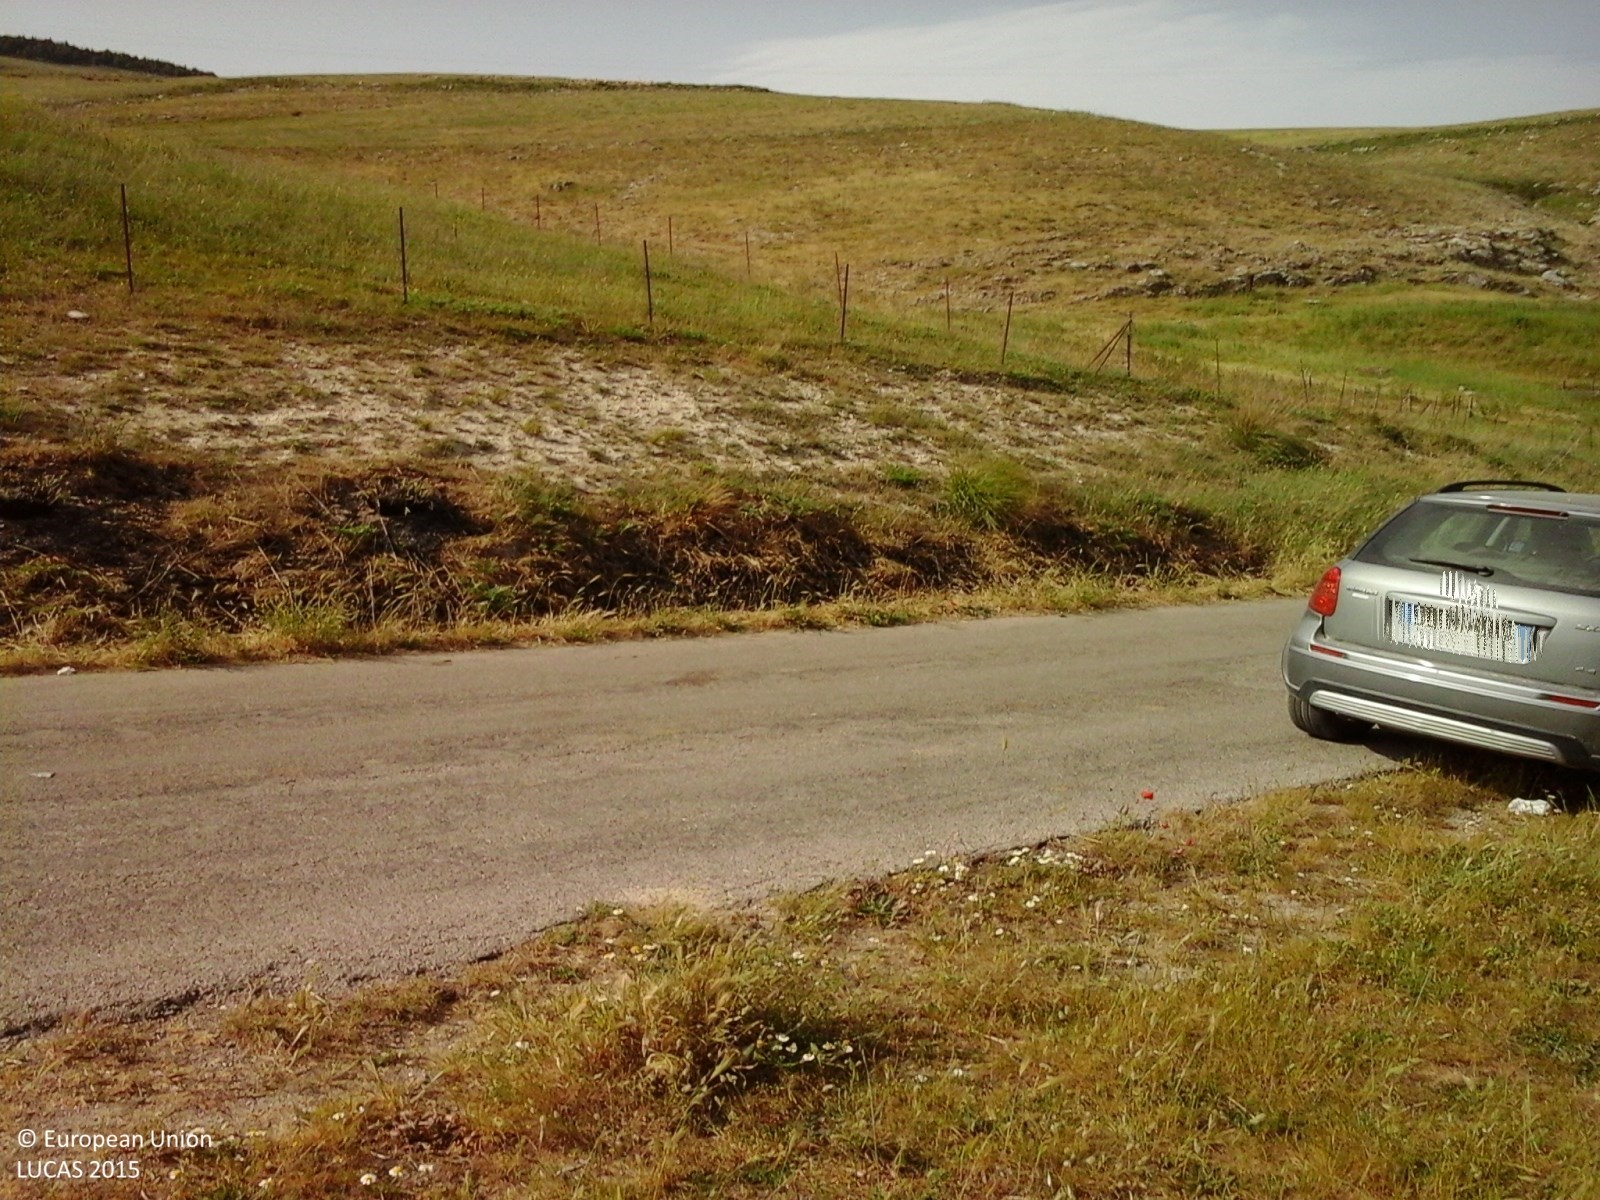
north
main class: Shrubland
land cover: Shrubland with sparse tree cover
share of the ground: > 75 %
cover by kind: shrubs 95 %, broadleaved forest trees 5 %
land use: Agriculture (excluding fallow land and kitchen gardens)
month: May
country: IT
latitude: 37.6279
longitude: 13.5203
